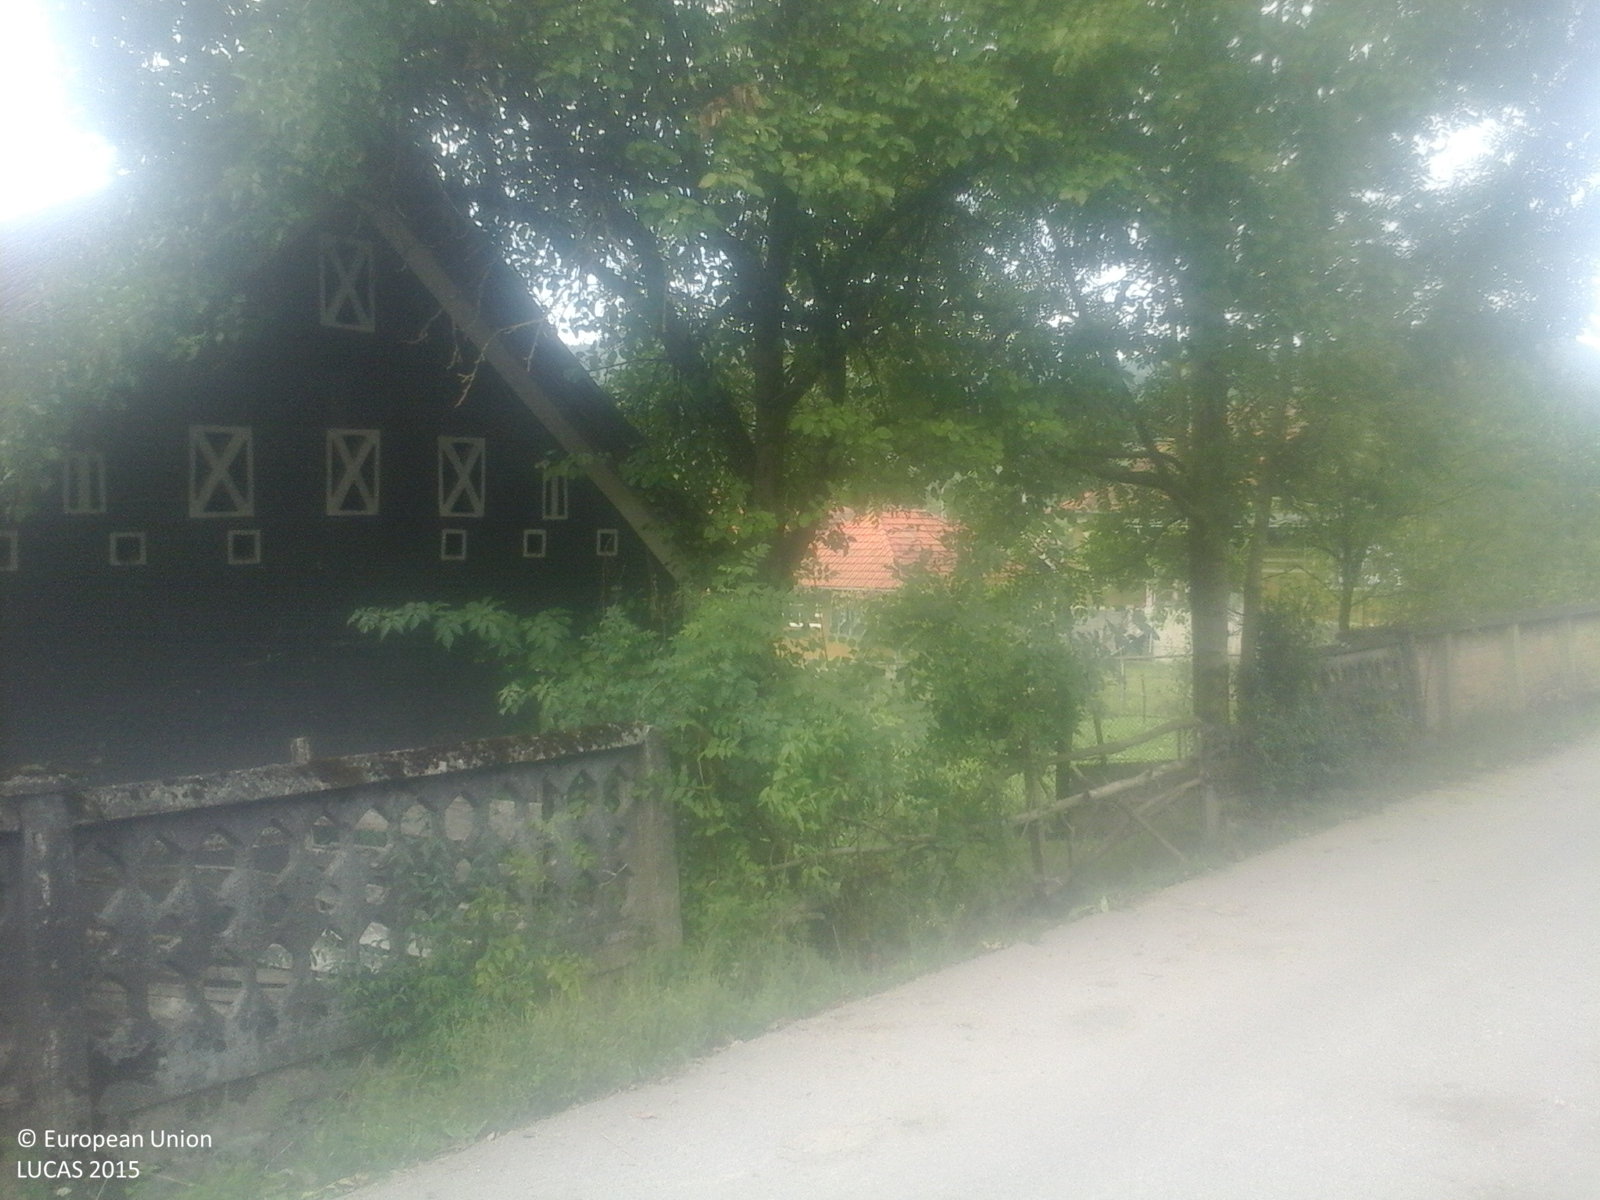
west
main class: Cropland
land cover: Other fruit trees and berries
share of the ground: 50 - 75 %
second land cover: Grassland without tree/shrub cover
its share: > 75 %
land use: Agriculture (excluding fallow land and kitchen gardens)
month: September
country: RO
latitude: 46.0565
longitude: 22.9161
